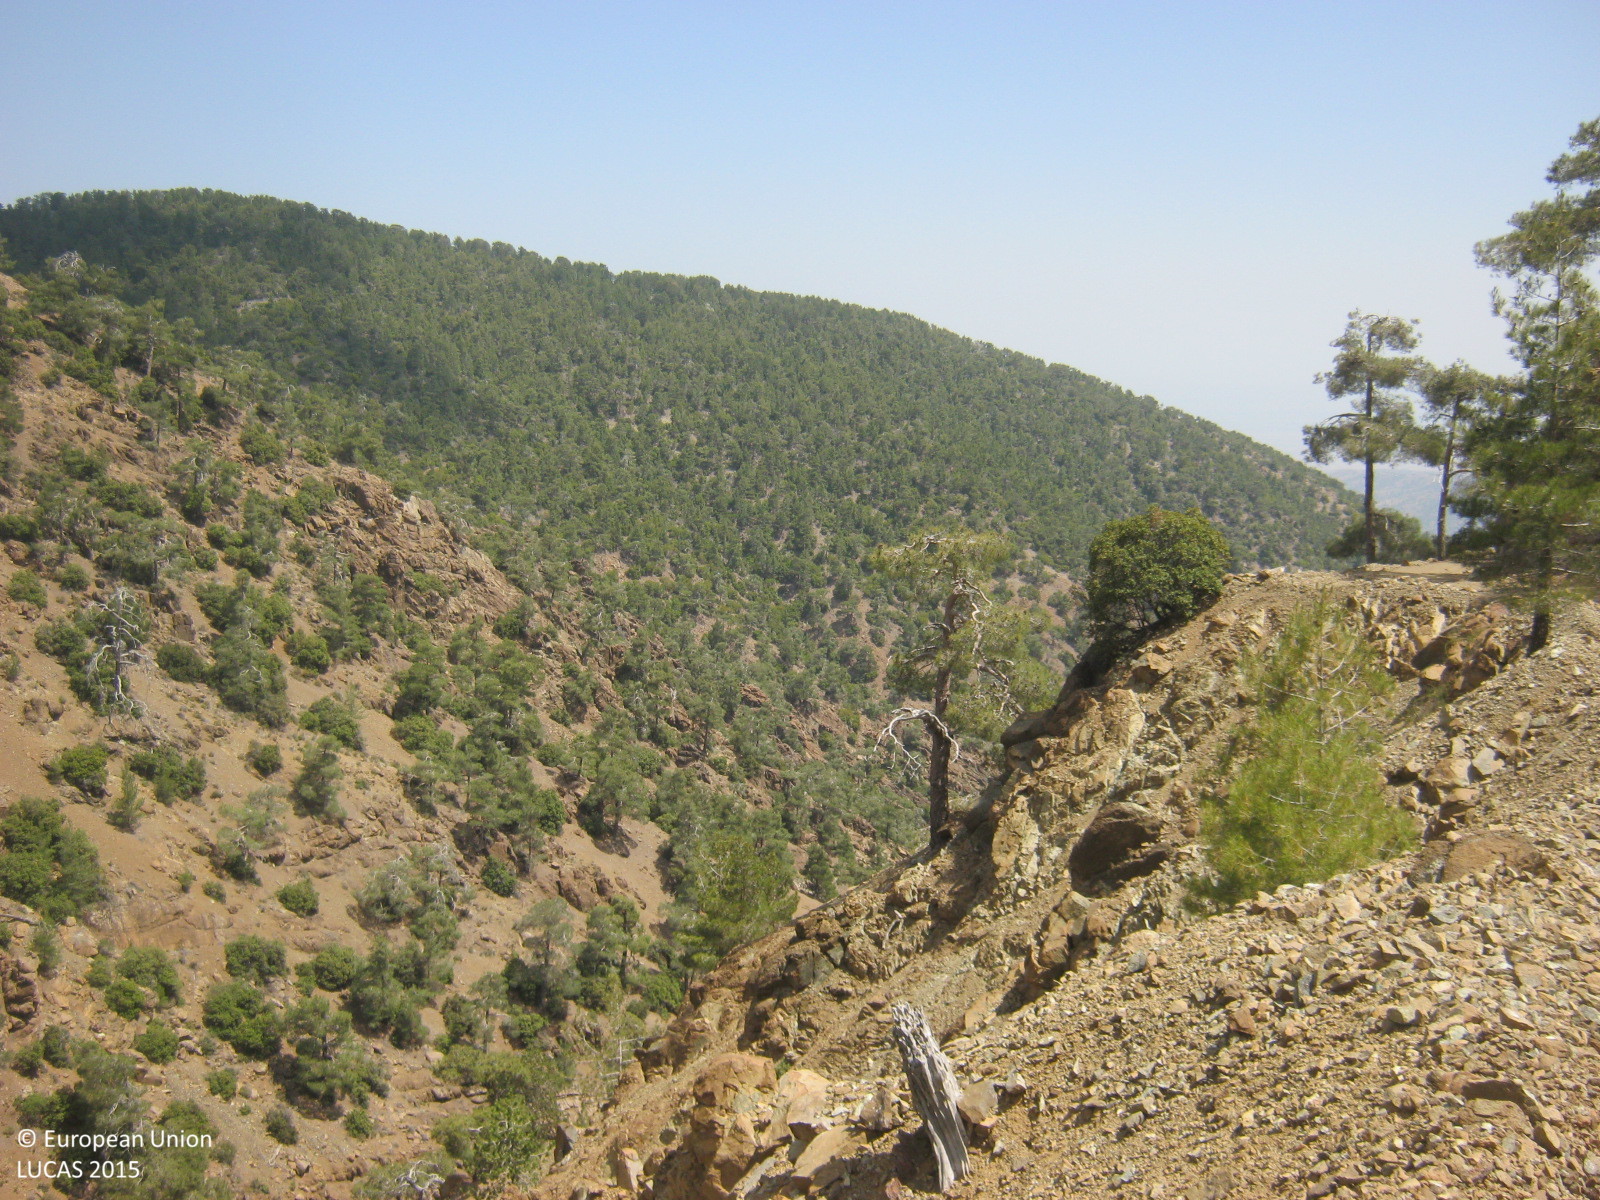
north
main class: Woodland
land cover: Pine dominated coniferous woodland
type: coniferous forest of the mediterranean region
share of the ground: 10 - 25 %
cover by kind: unconsolidated bare surface 65 %, coniferous forest trees 15 %, shrubs 10 %, consolidated bare surface 10 %
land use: Forestry
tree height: > 5 m
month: June
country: CY
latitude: 34.9585
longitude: 32.8693
